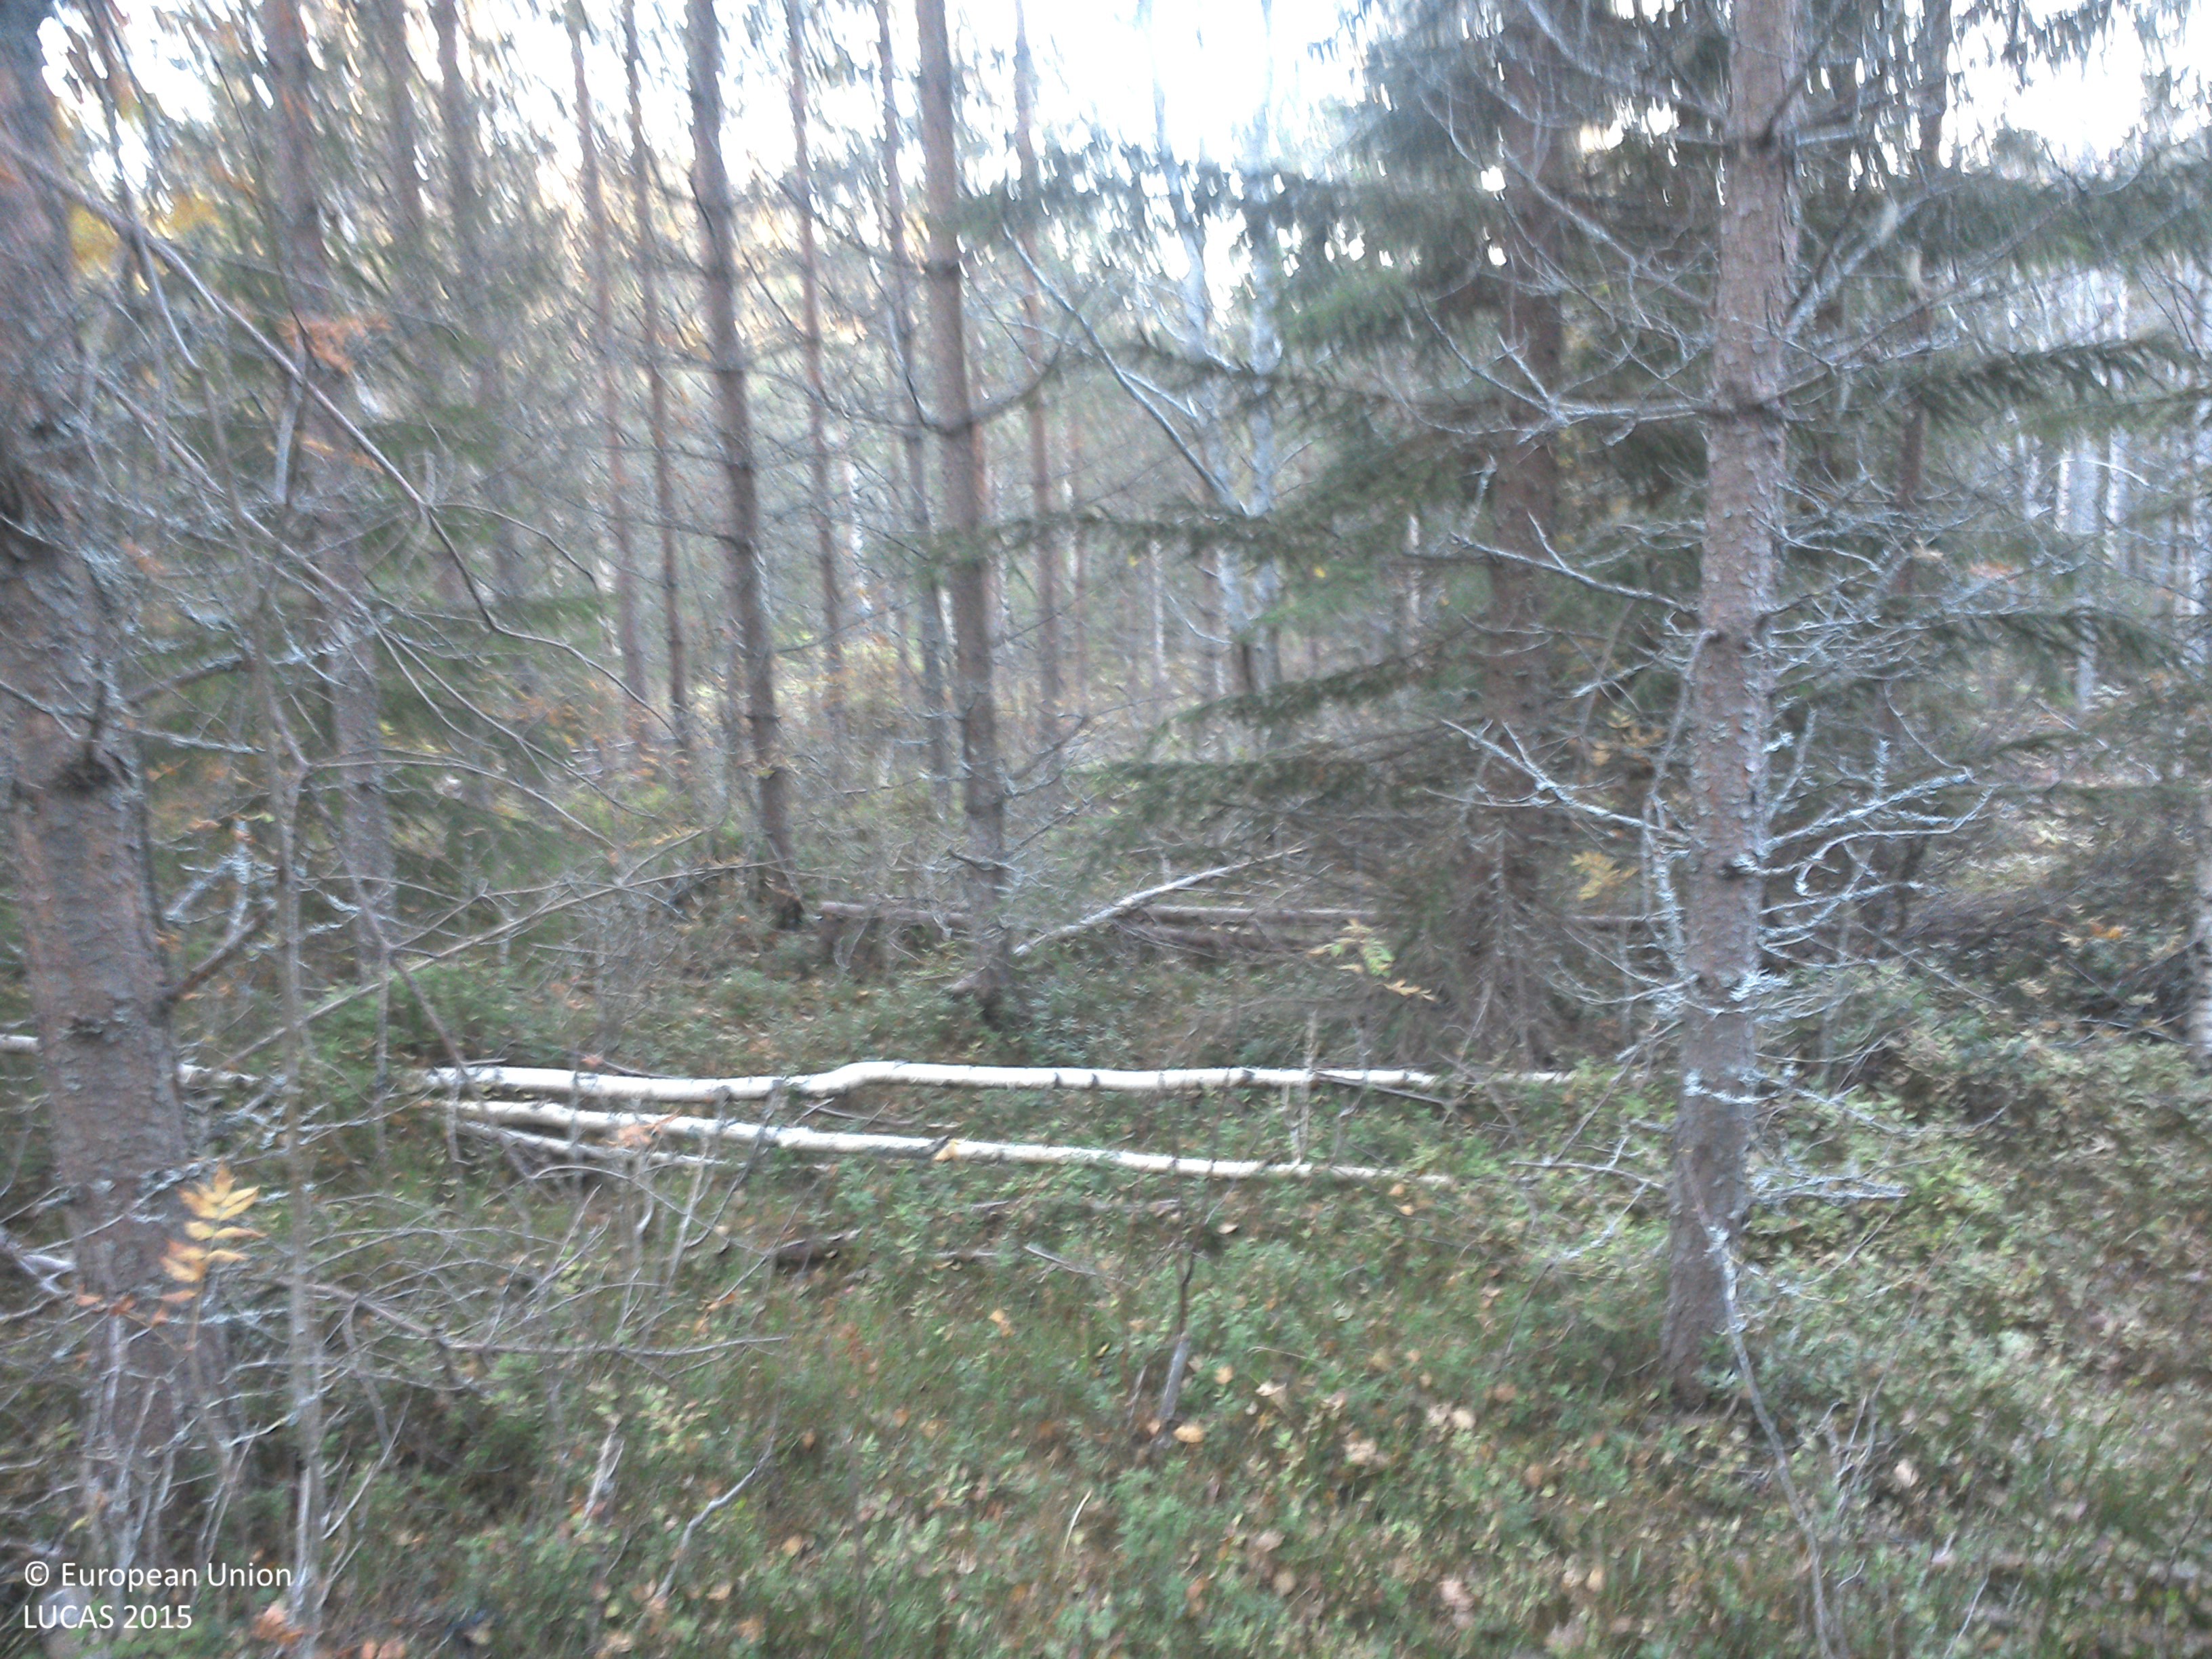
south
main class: Woodland
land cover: Other mixed woodland
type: boreal forest
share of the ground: 50 - 75 %
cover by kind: shrubs 45 %, coniferous forest trees 30 %, broadleaved forest trees 25 %
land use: Forestry
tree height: > 5 m
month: October
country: SE
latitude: 63.8931
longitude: 19.8163
